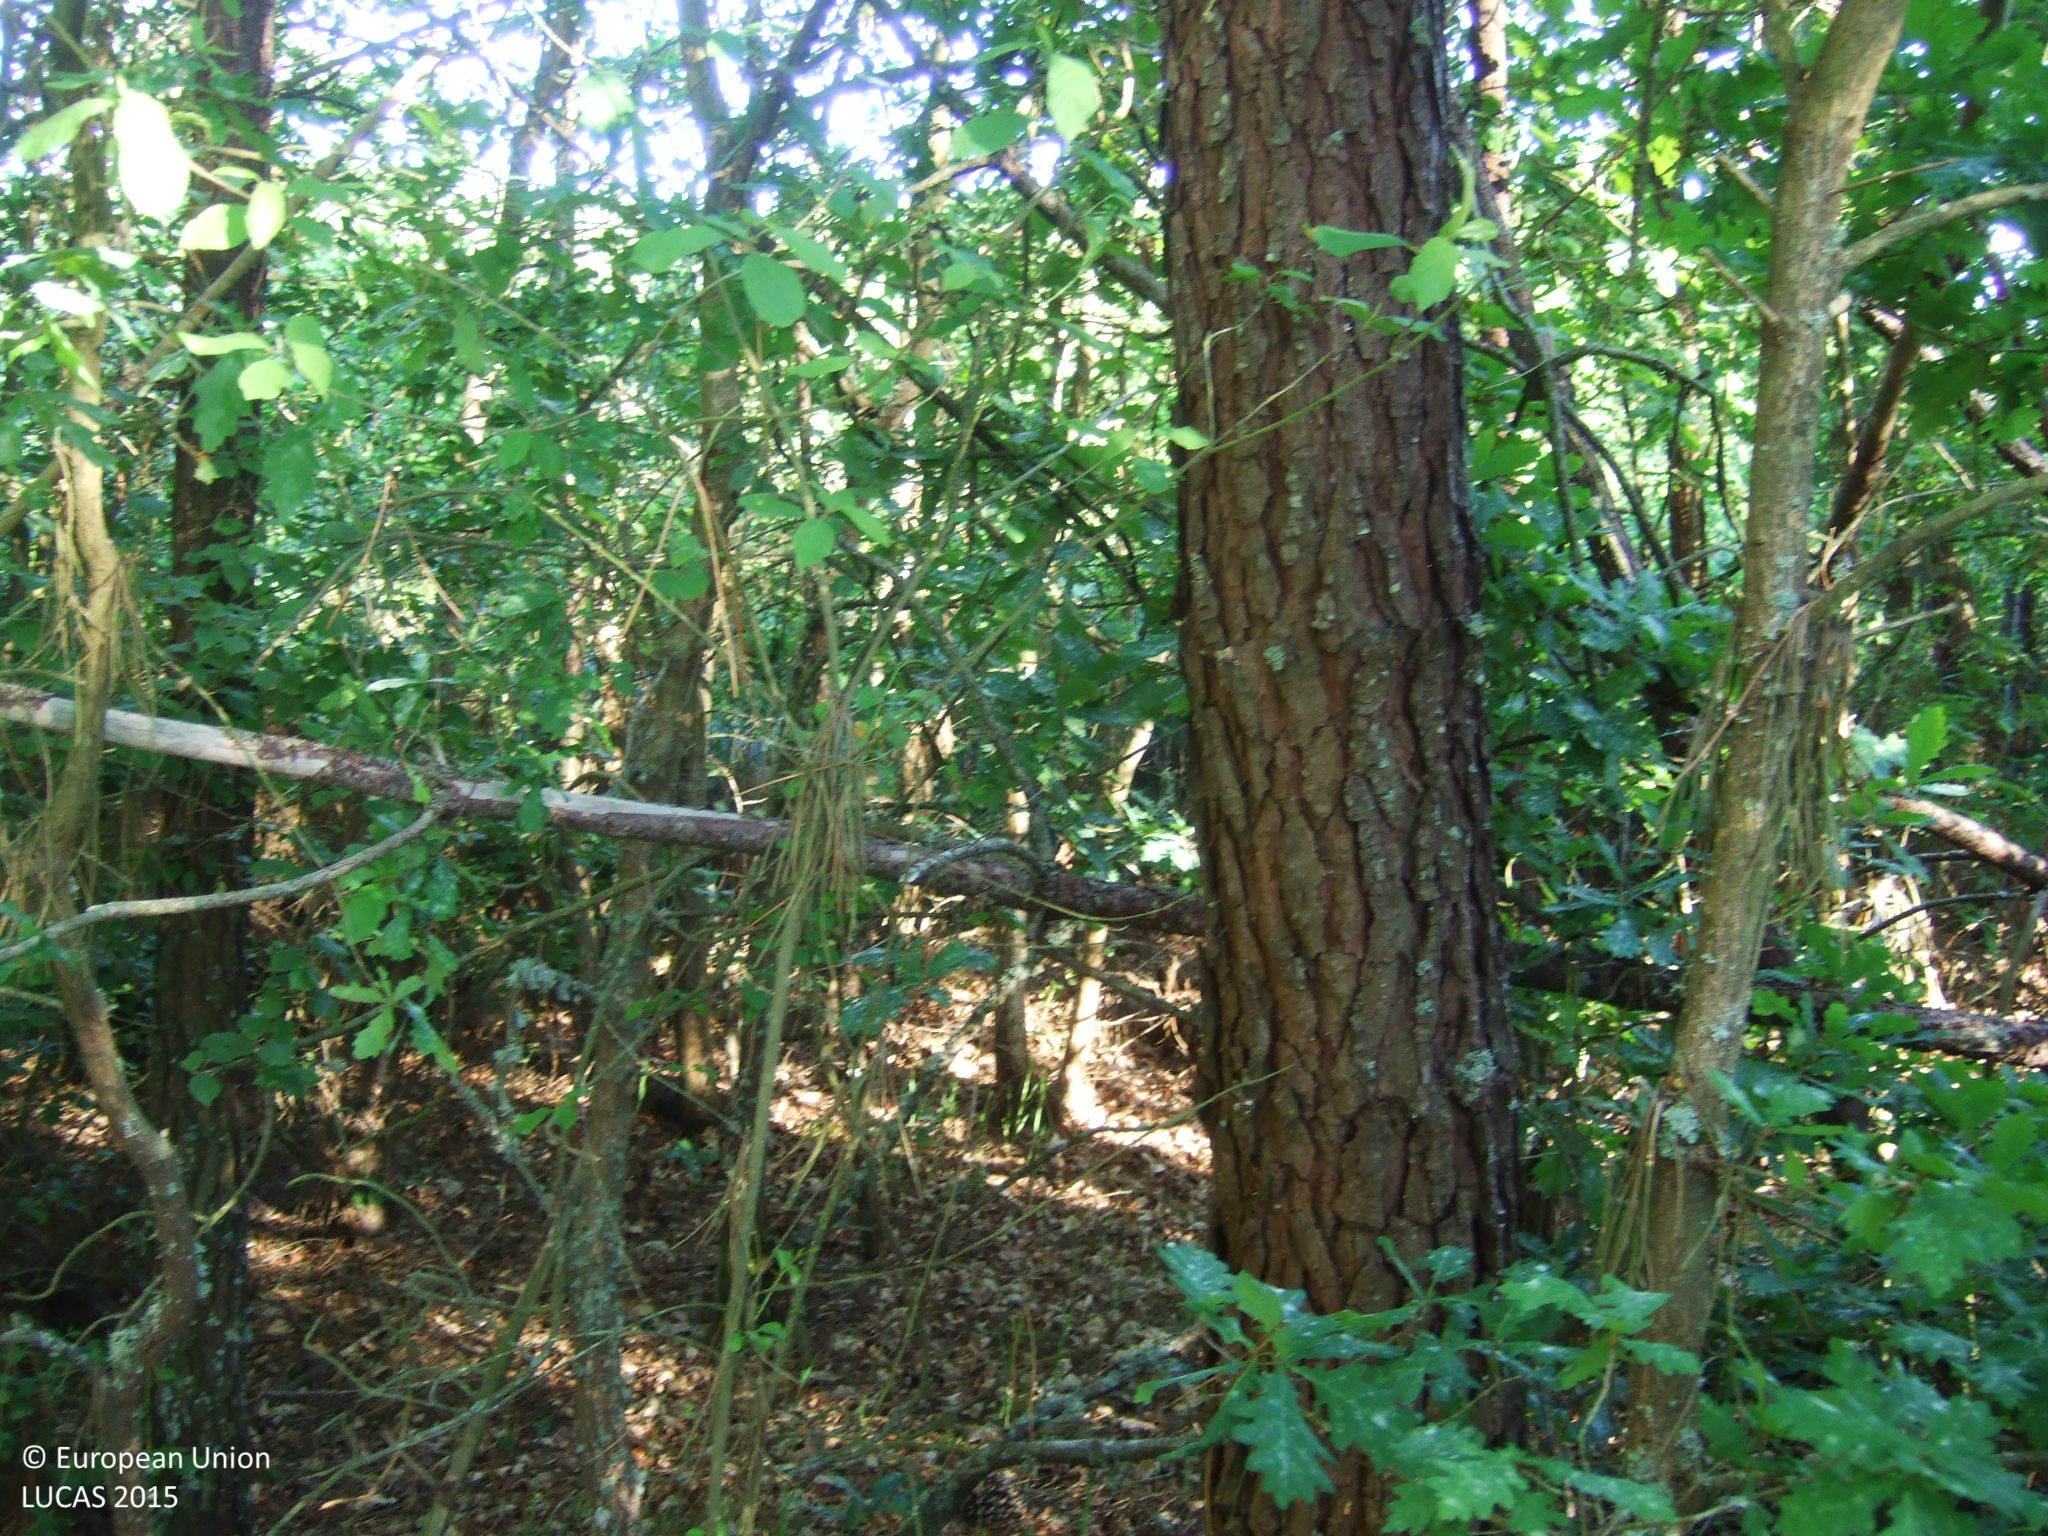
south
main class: Woodland
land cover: Pine dominated coniferous woodland
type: exotic forest
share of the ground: 50 - 75 %
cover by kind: coniferous forest trees 65 %, unconsolidated bare surface 20 %, shrubs 10 %, broadleaved forest trees 5 %
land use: Forestry
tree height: > 5 m
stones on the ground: < 10 %
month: May
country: ES
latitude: 42.7339
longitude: -7.5269
